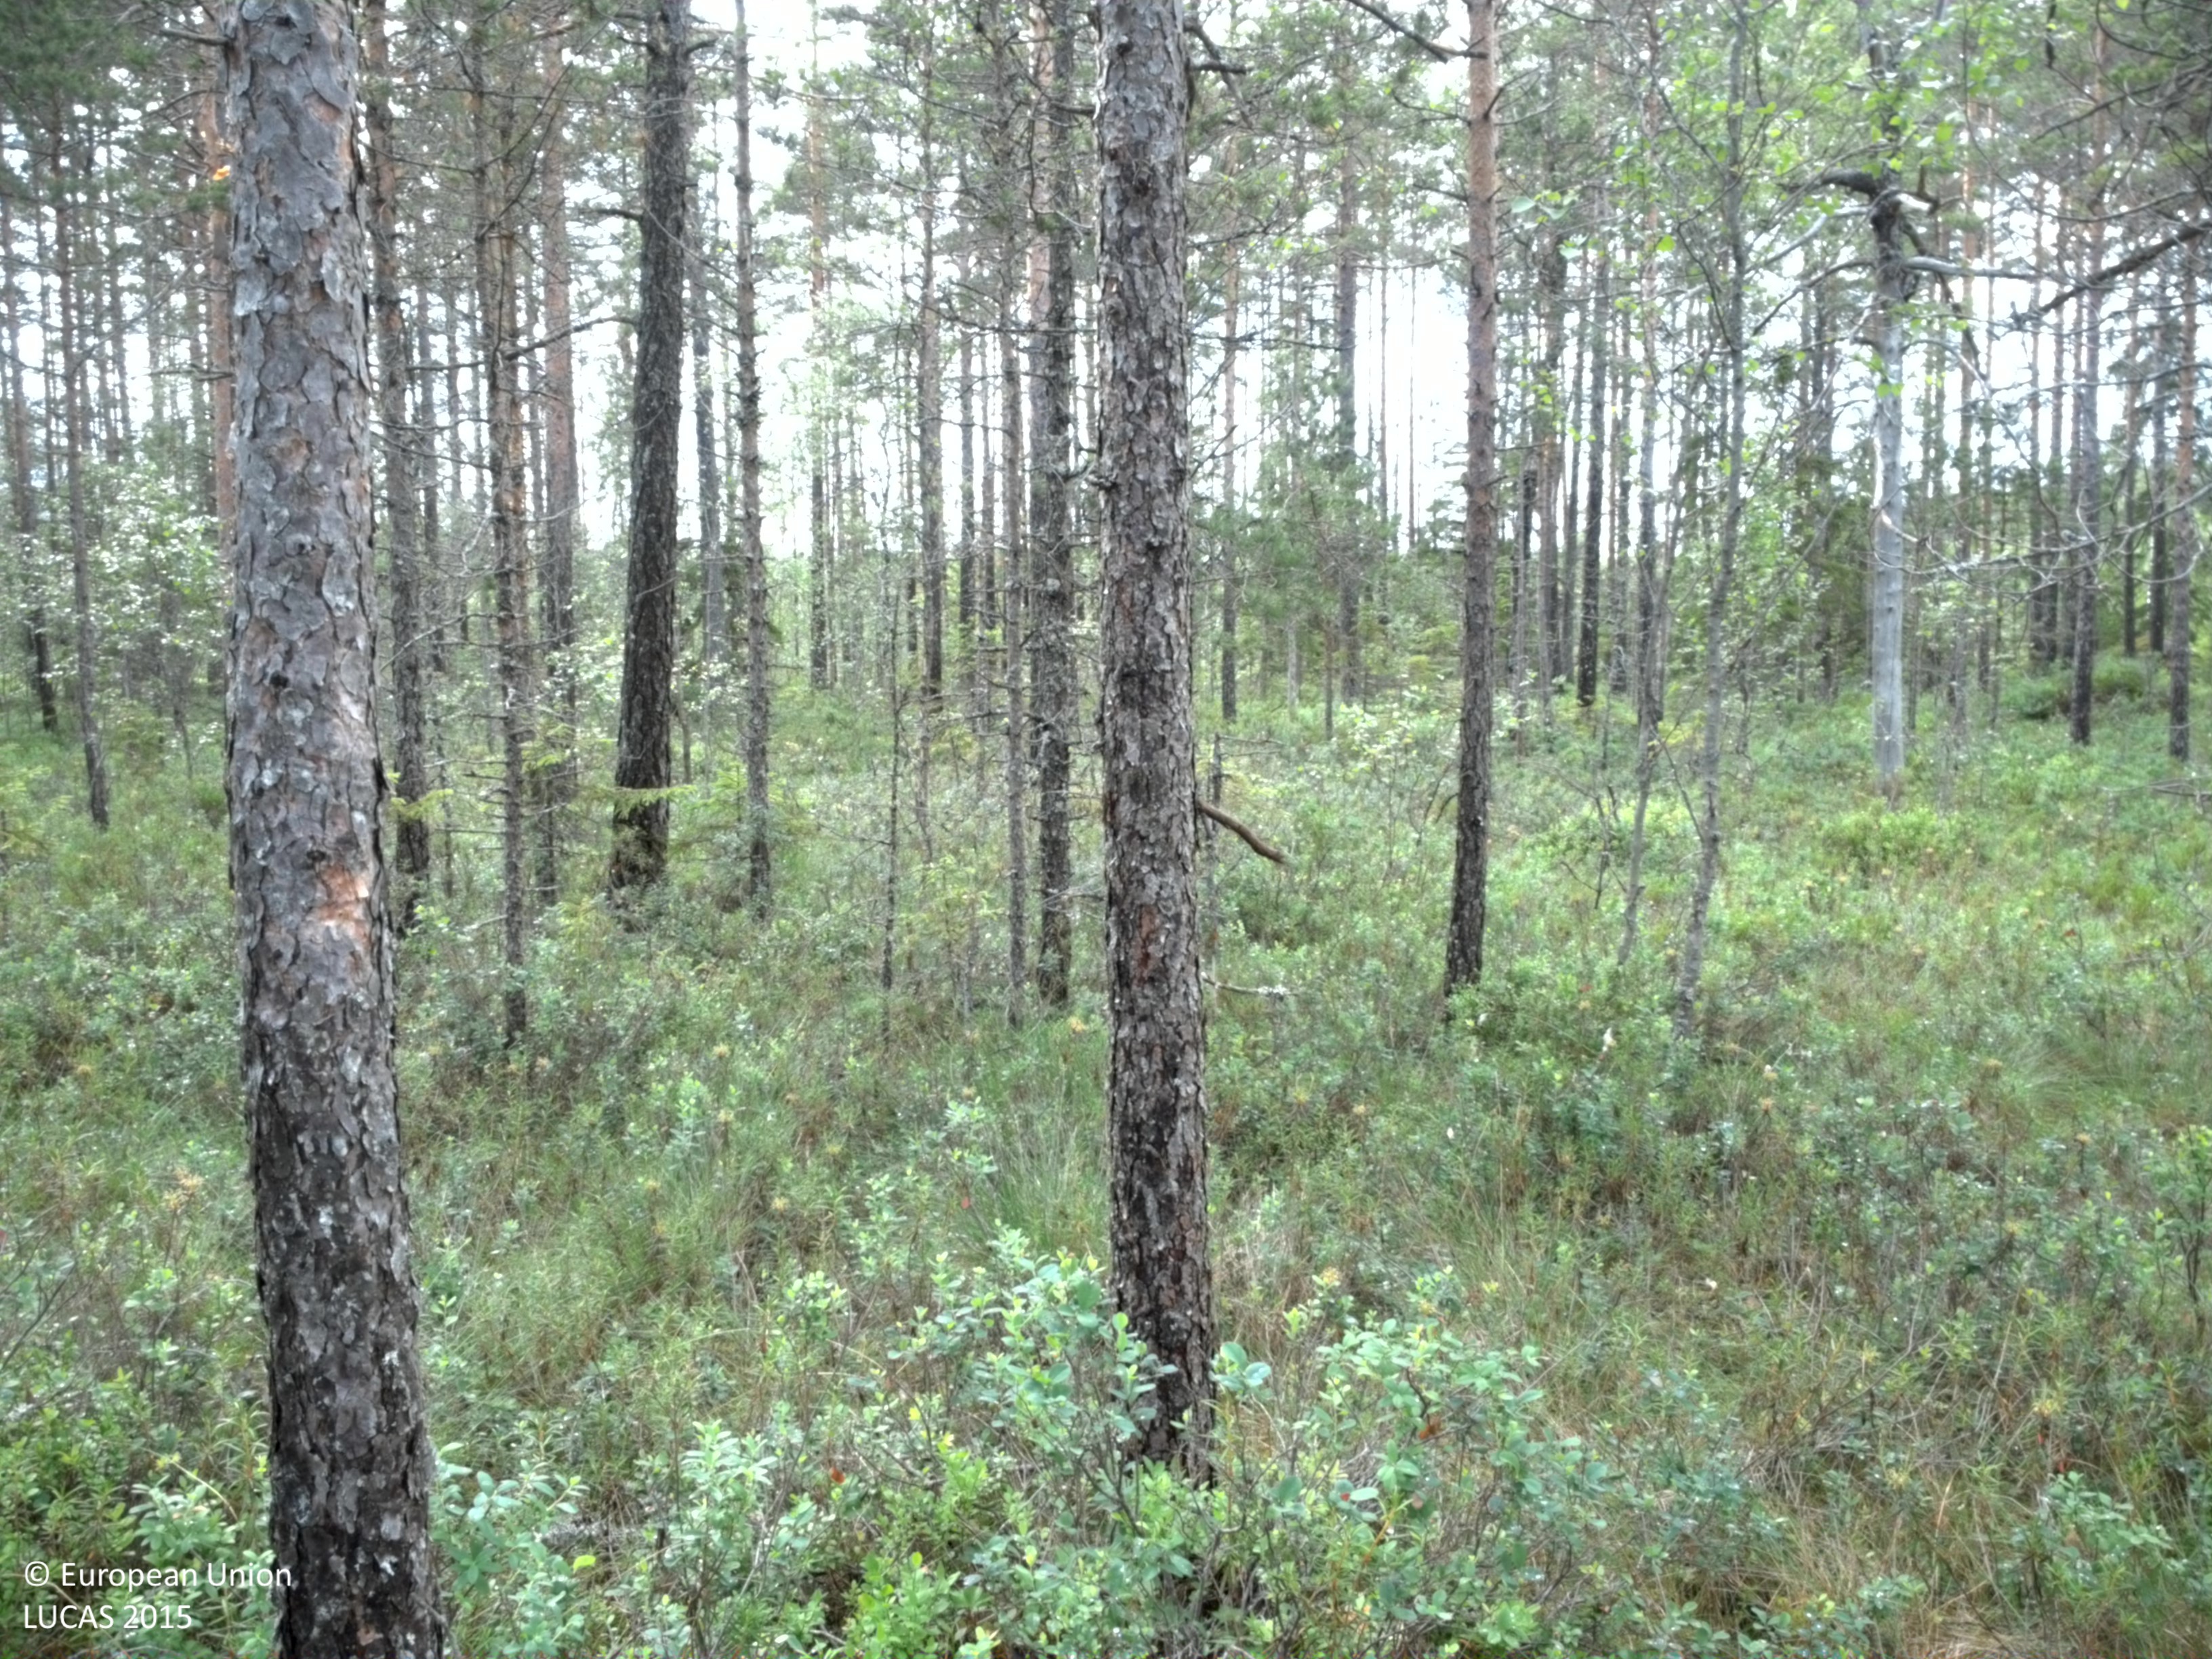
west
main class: Woodland
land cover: Pine dominated mixed woodland
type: mire and swamp forests
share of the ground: 50 - 75 %
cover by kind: coniferous forest trees 50 %, broadleaved forest trees 20 %, shrubs 20 %, herbaceous plants 5 %, lichens and mosses 5 %
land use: Forestry
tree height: > 5 m
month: July
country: SE
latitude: 59.4711
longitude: 14.7033
